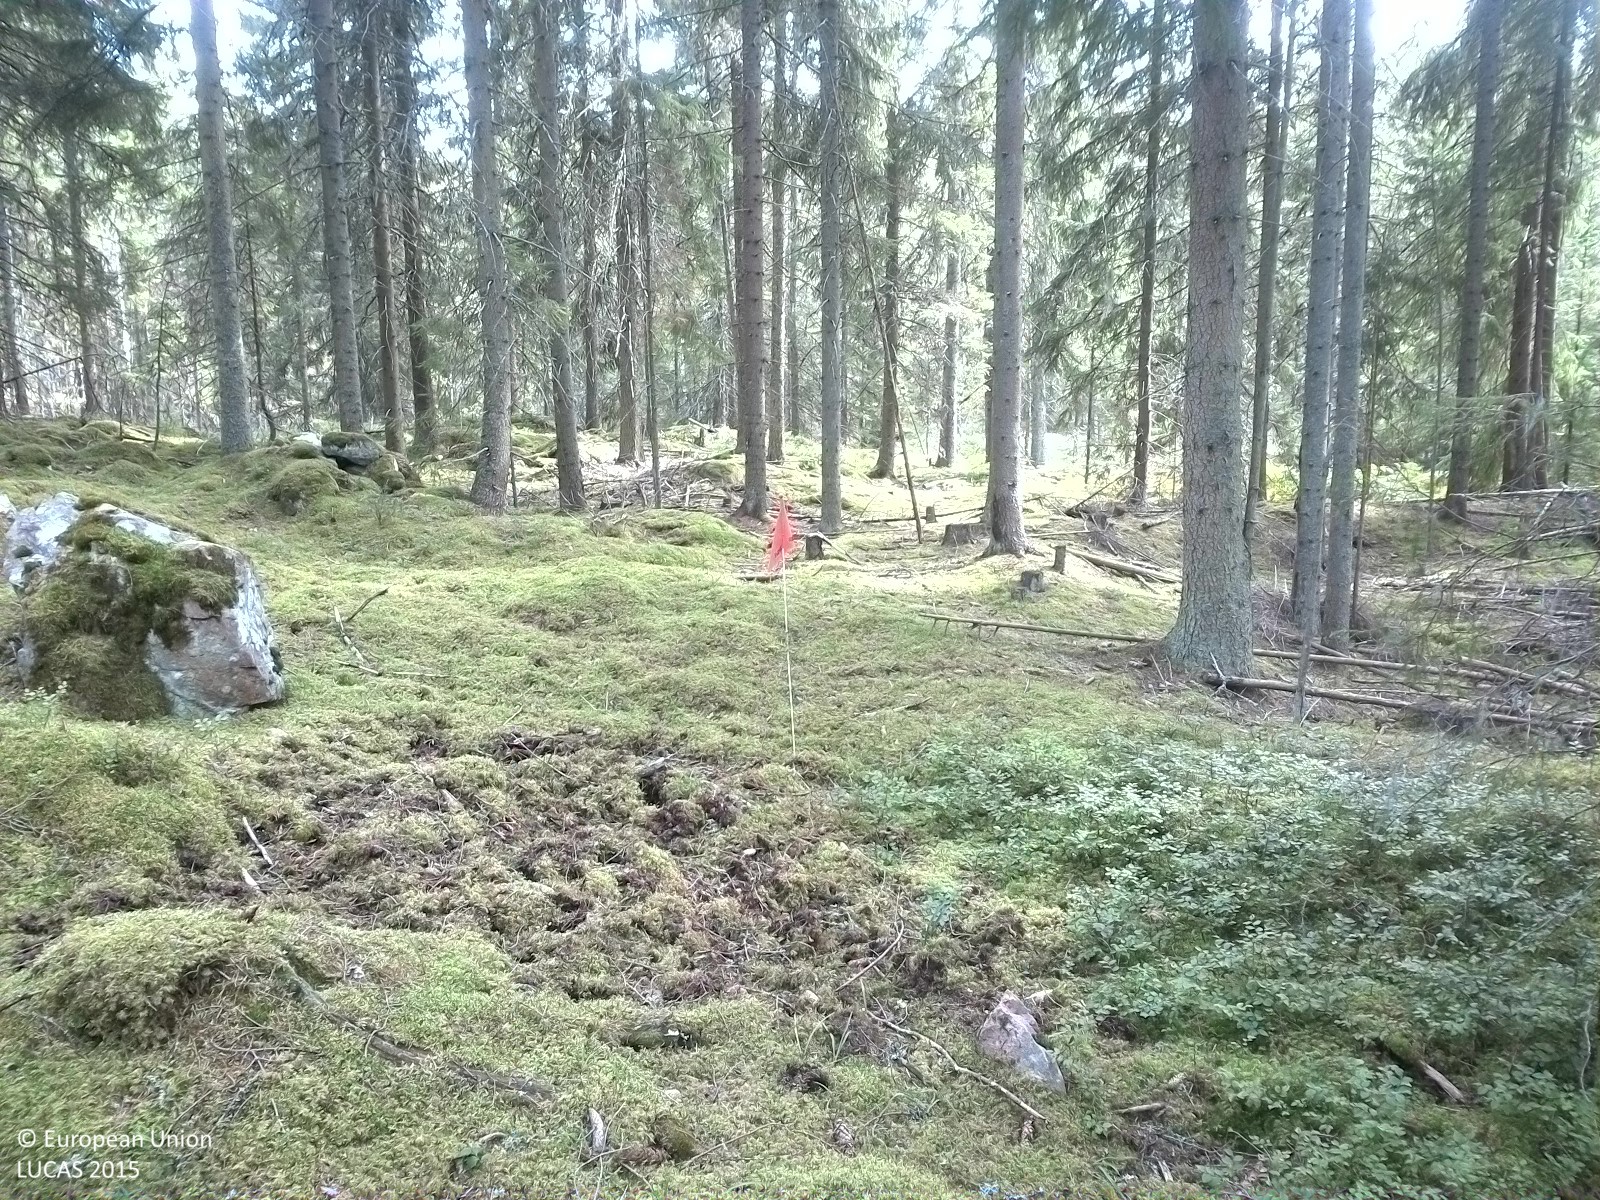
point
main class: Woodland
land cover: Spruce dominated coniferous woodland
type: boreal forest
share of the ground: 25 - 50 %
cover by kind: lichens and mosses 50 %, coniferous forest trees 40 %, herbaceous plants 10 %
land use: Forestry
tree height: > 5 m
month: August
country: SE
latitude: 58.8787
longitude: 15.5960
